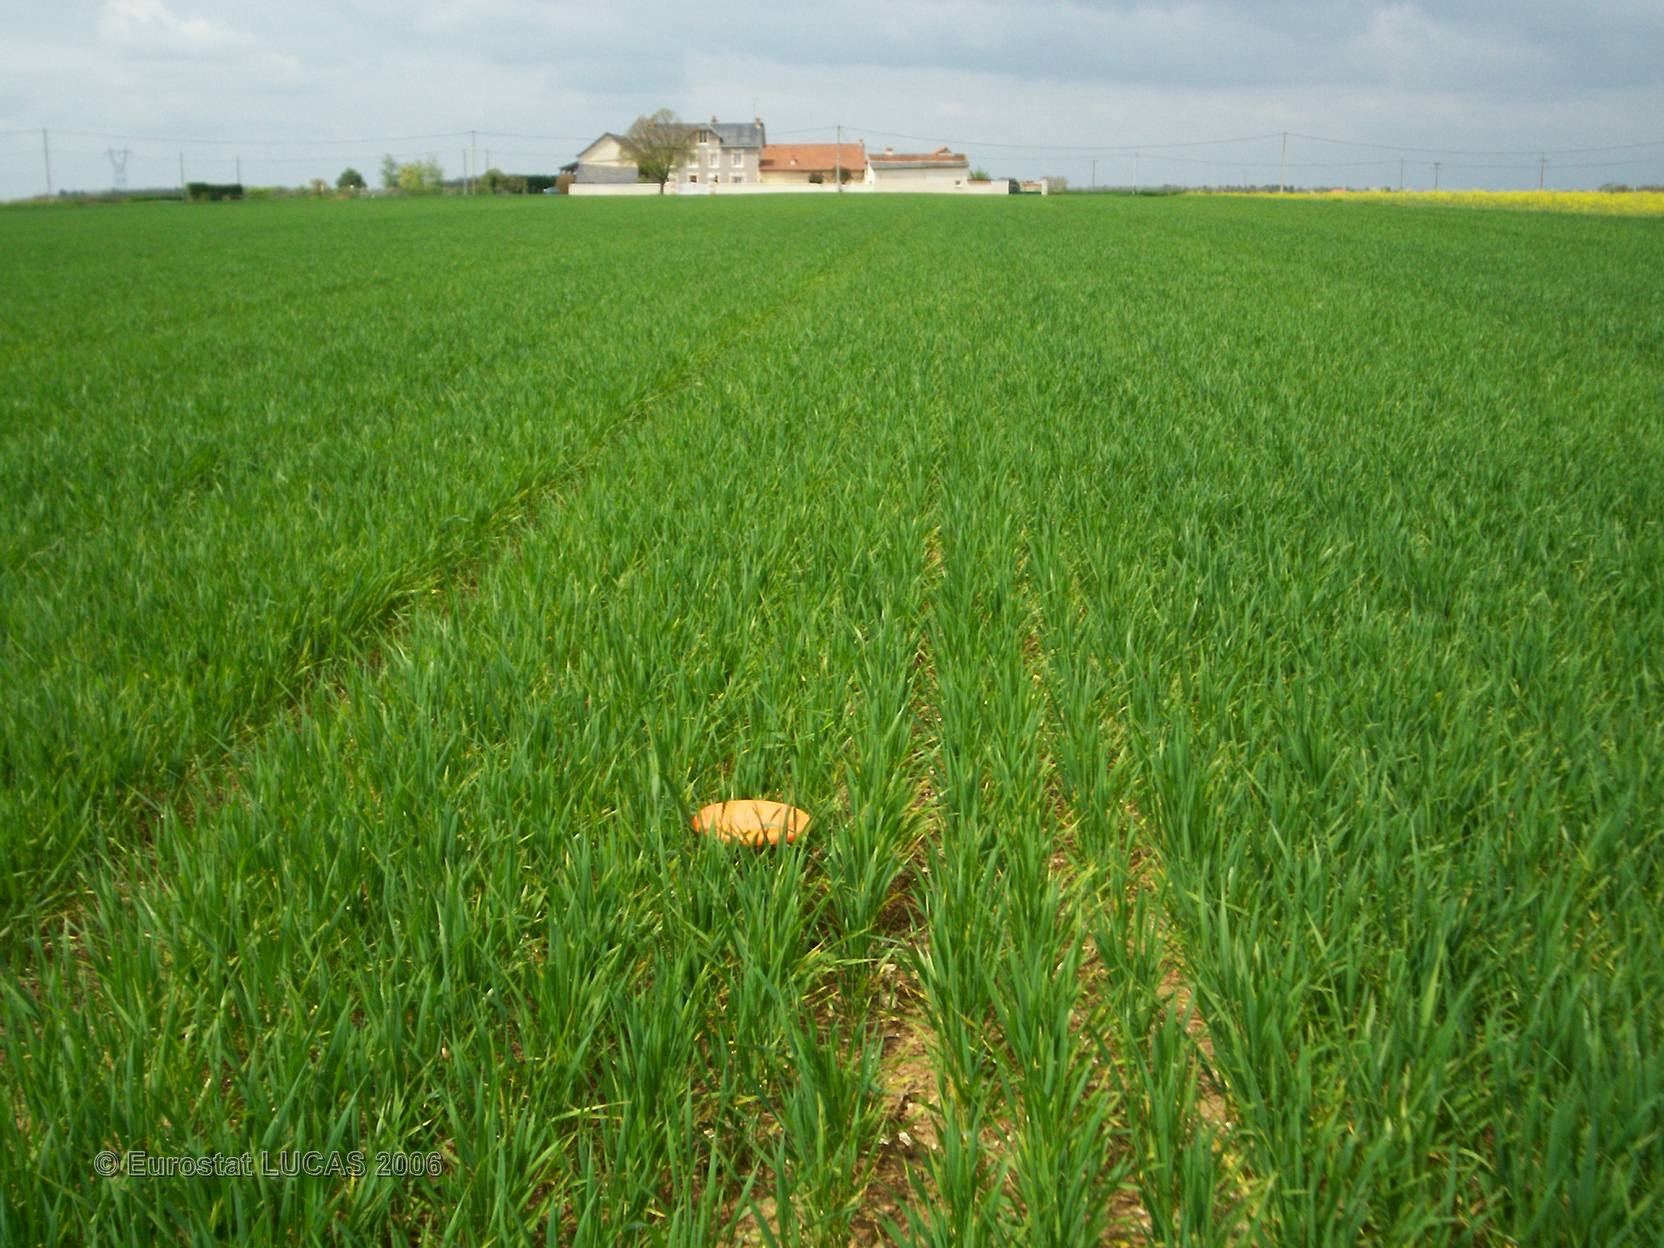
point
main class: Cropland
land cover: Barley
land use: Agriculture (excluding fallow land and kitchen gardens)
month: April
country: FR
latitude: 47.0449
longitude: 0.2248
